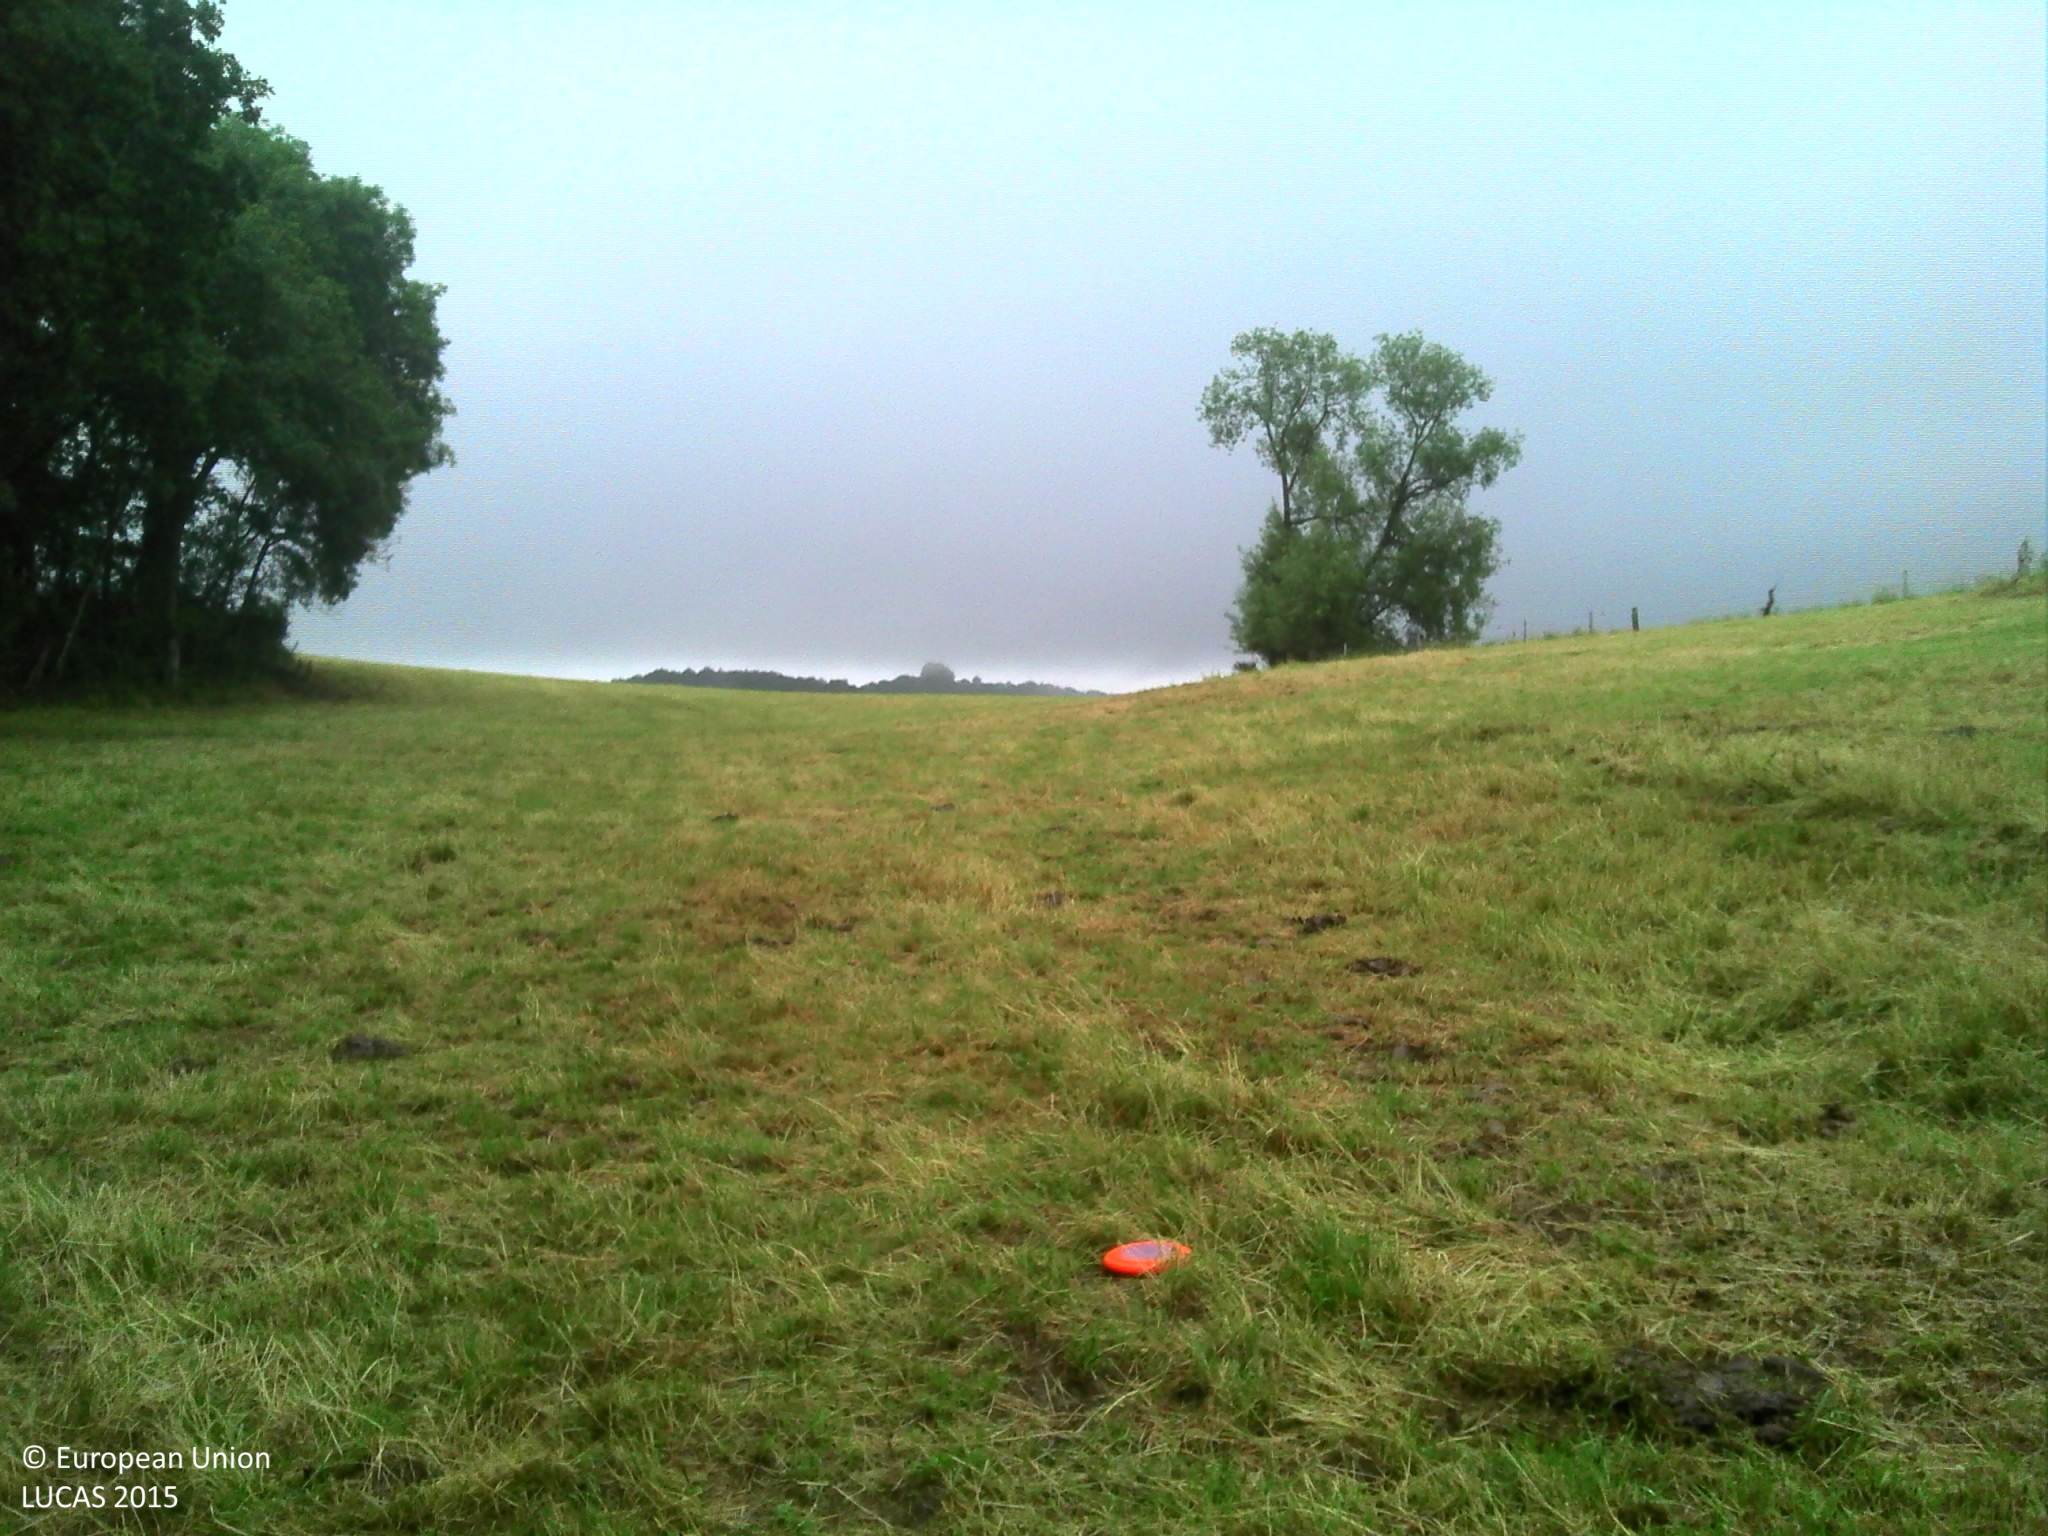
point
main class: Grassland
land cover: Grassland without tree/shrub cover
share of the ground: > 75 %
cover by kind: herbaceous plants 100 %
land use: Agriculture (excluding fallow land and kitchen gardens)
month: June
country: BE
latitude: 50.2753
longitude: 5.4941
